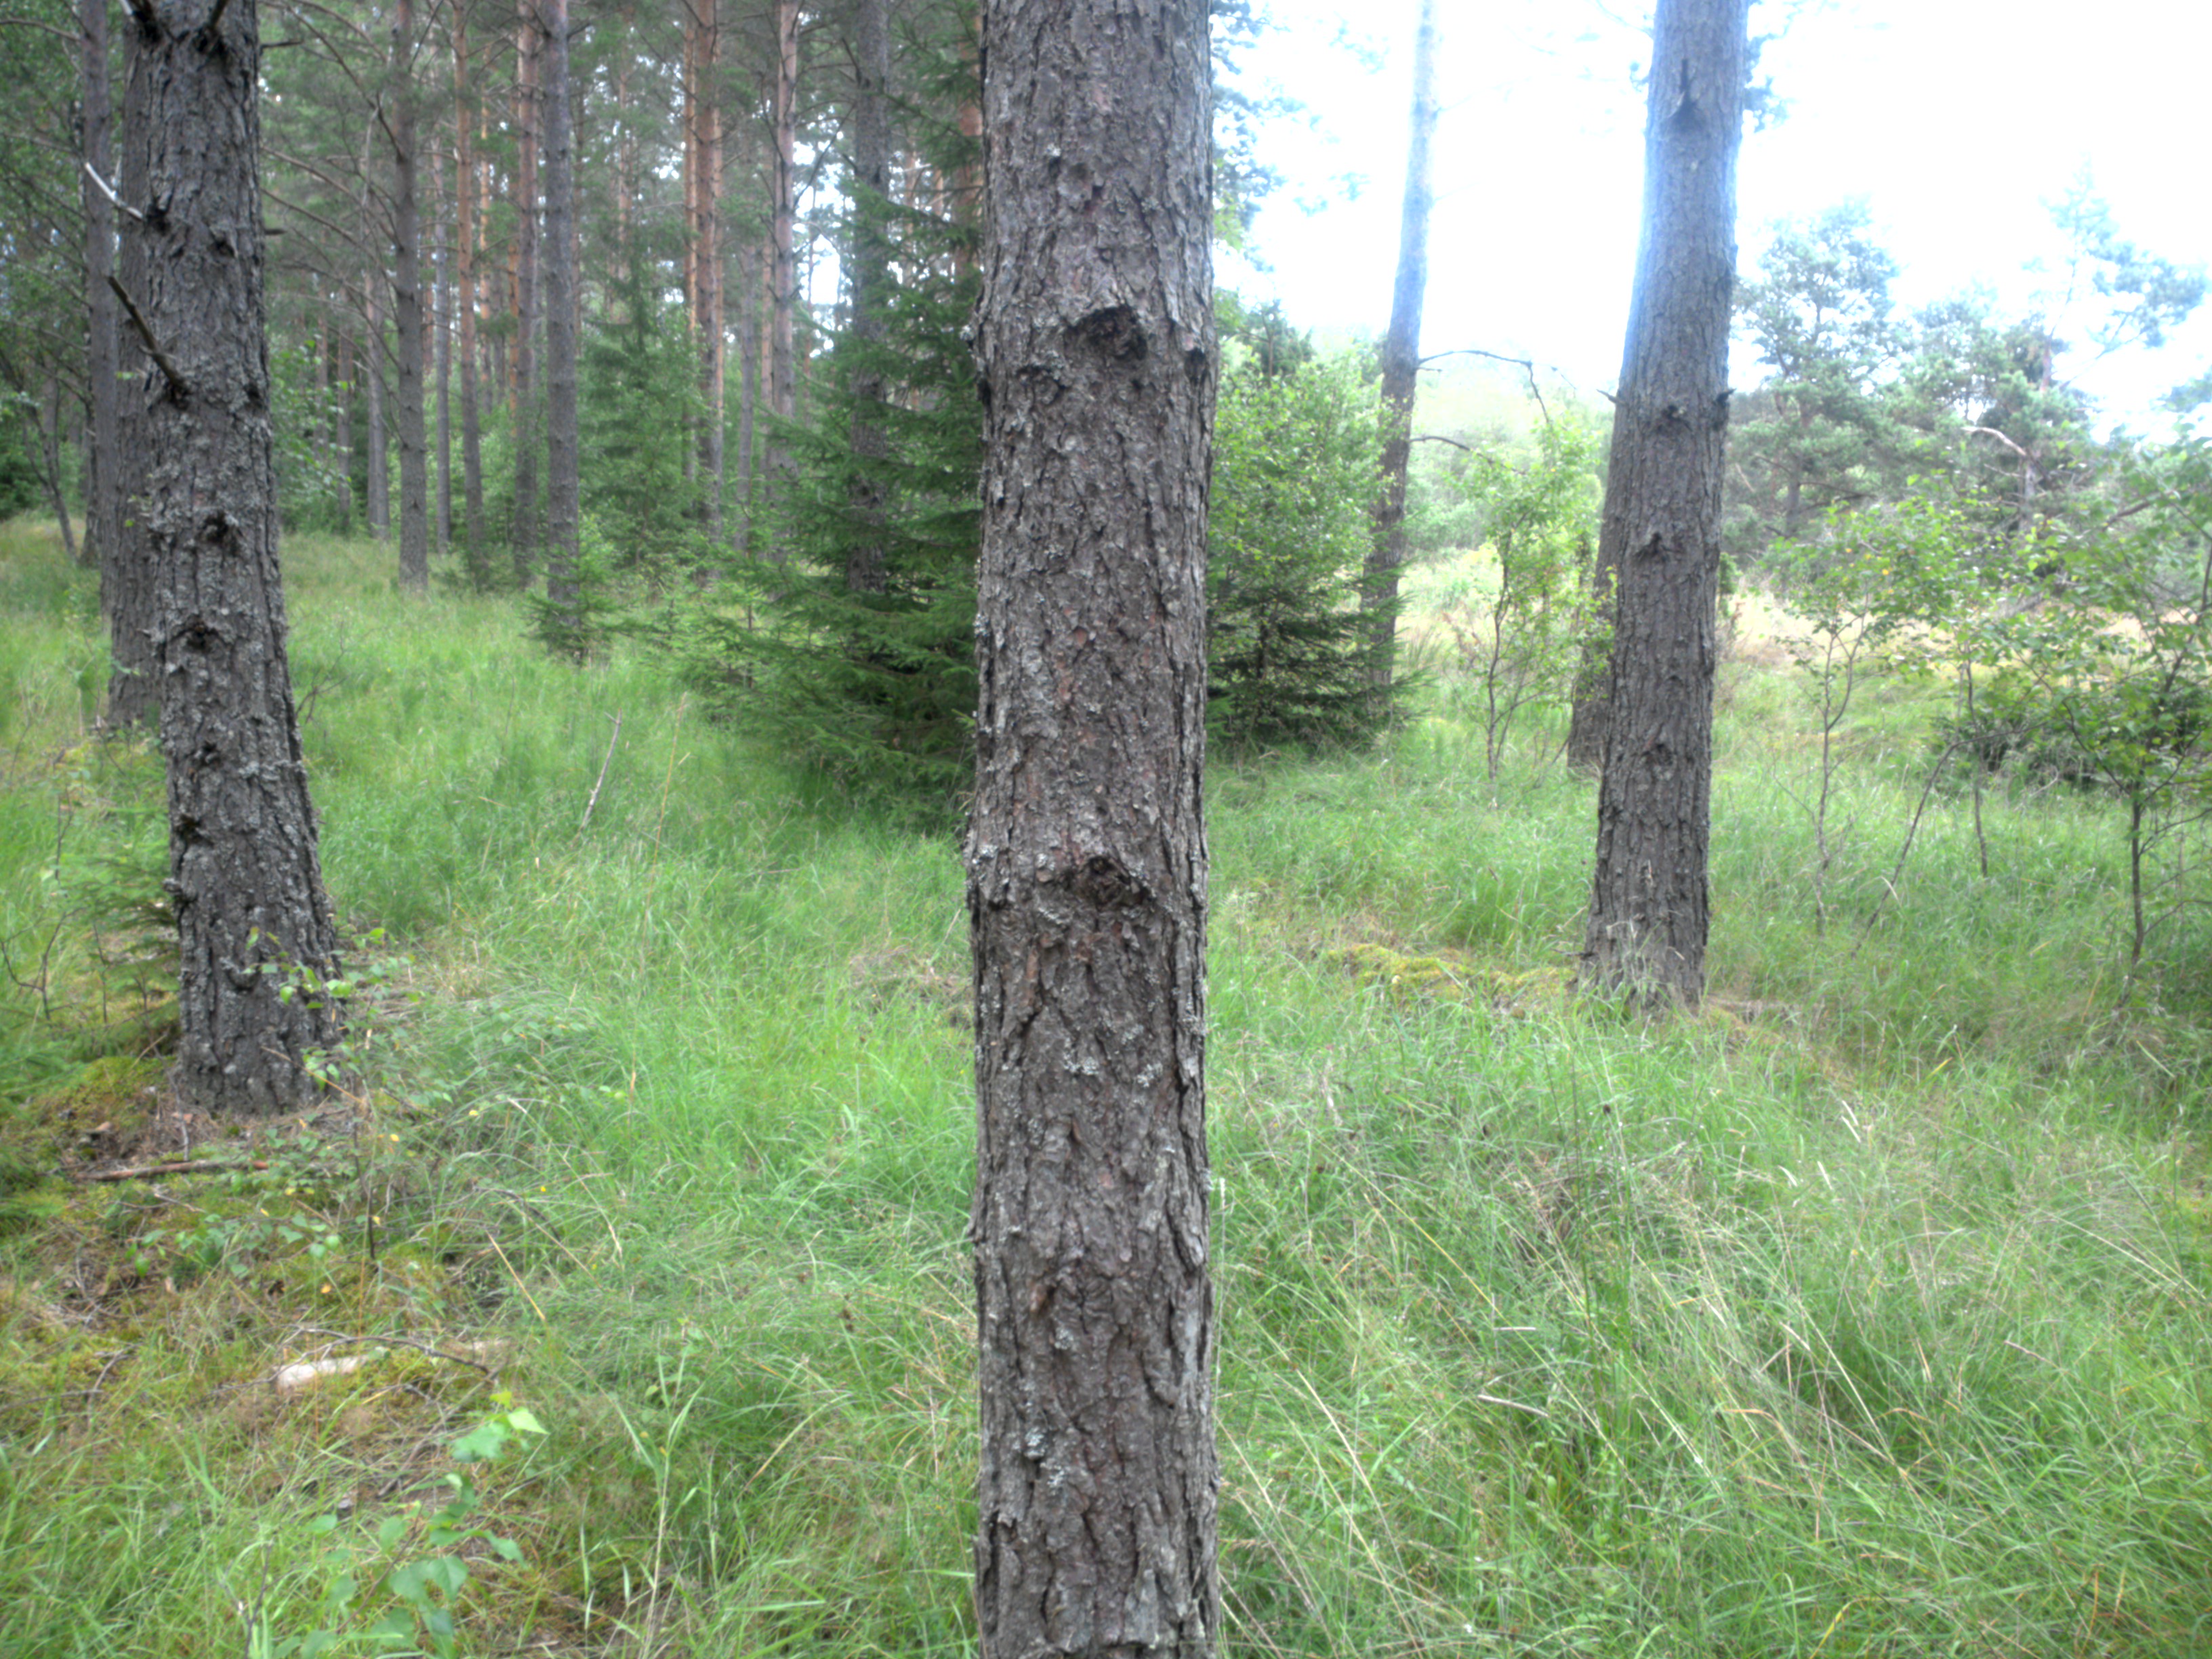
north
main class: Woodland
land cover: Pine dominated coniferous woodland
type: boreal forest
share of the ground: 50 - 75 %
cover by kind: coniferous forest trees 65 %, herbaceous plants 35 %
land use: Forestry
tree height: > 5 m
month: July
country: SE
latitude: 59.1452
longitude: 18.1988
